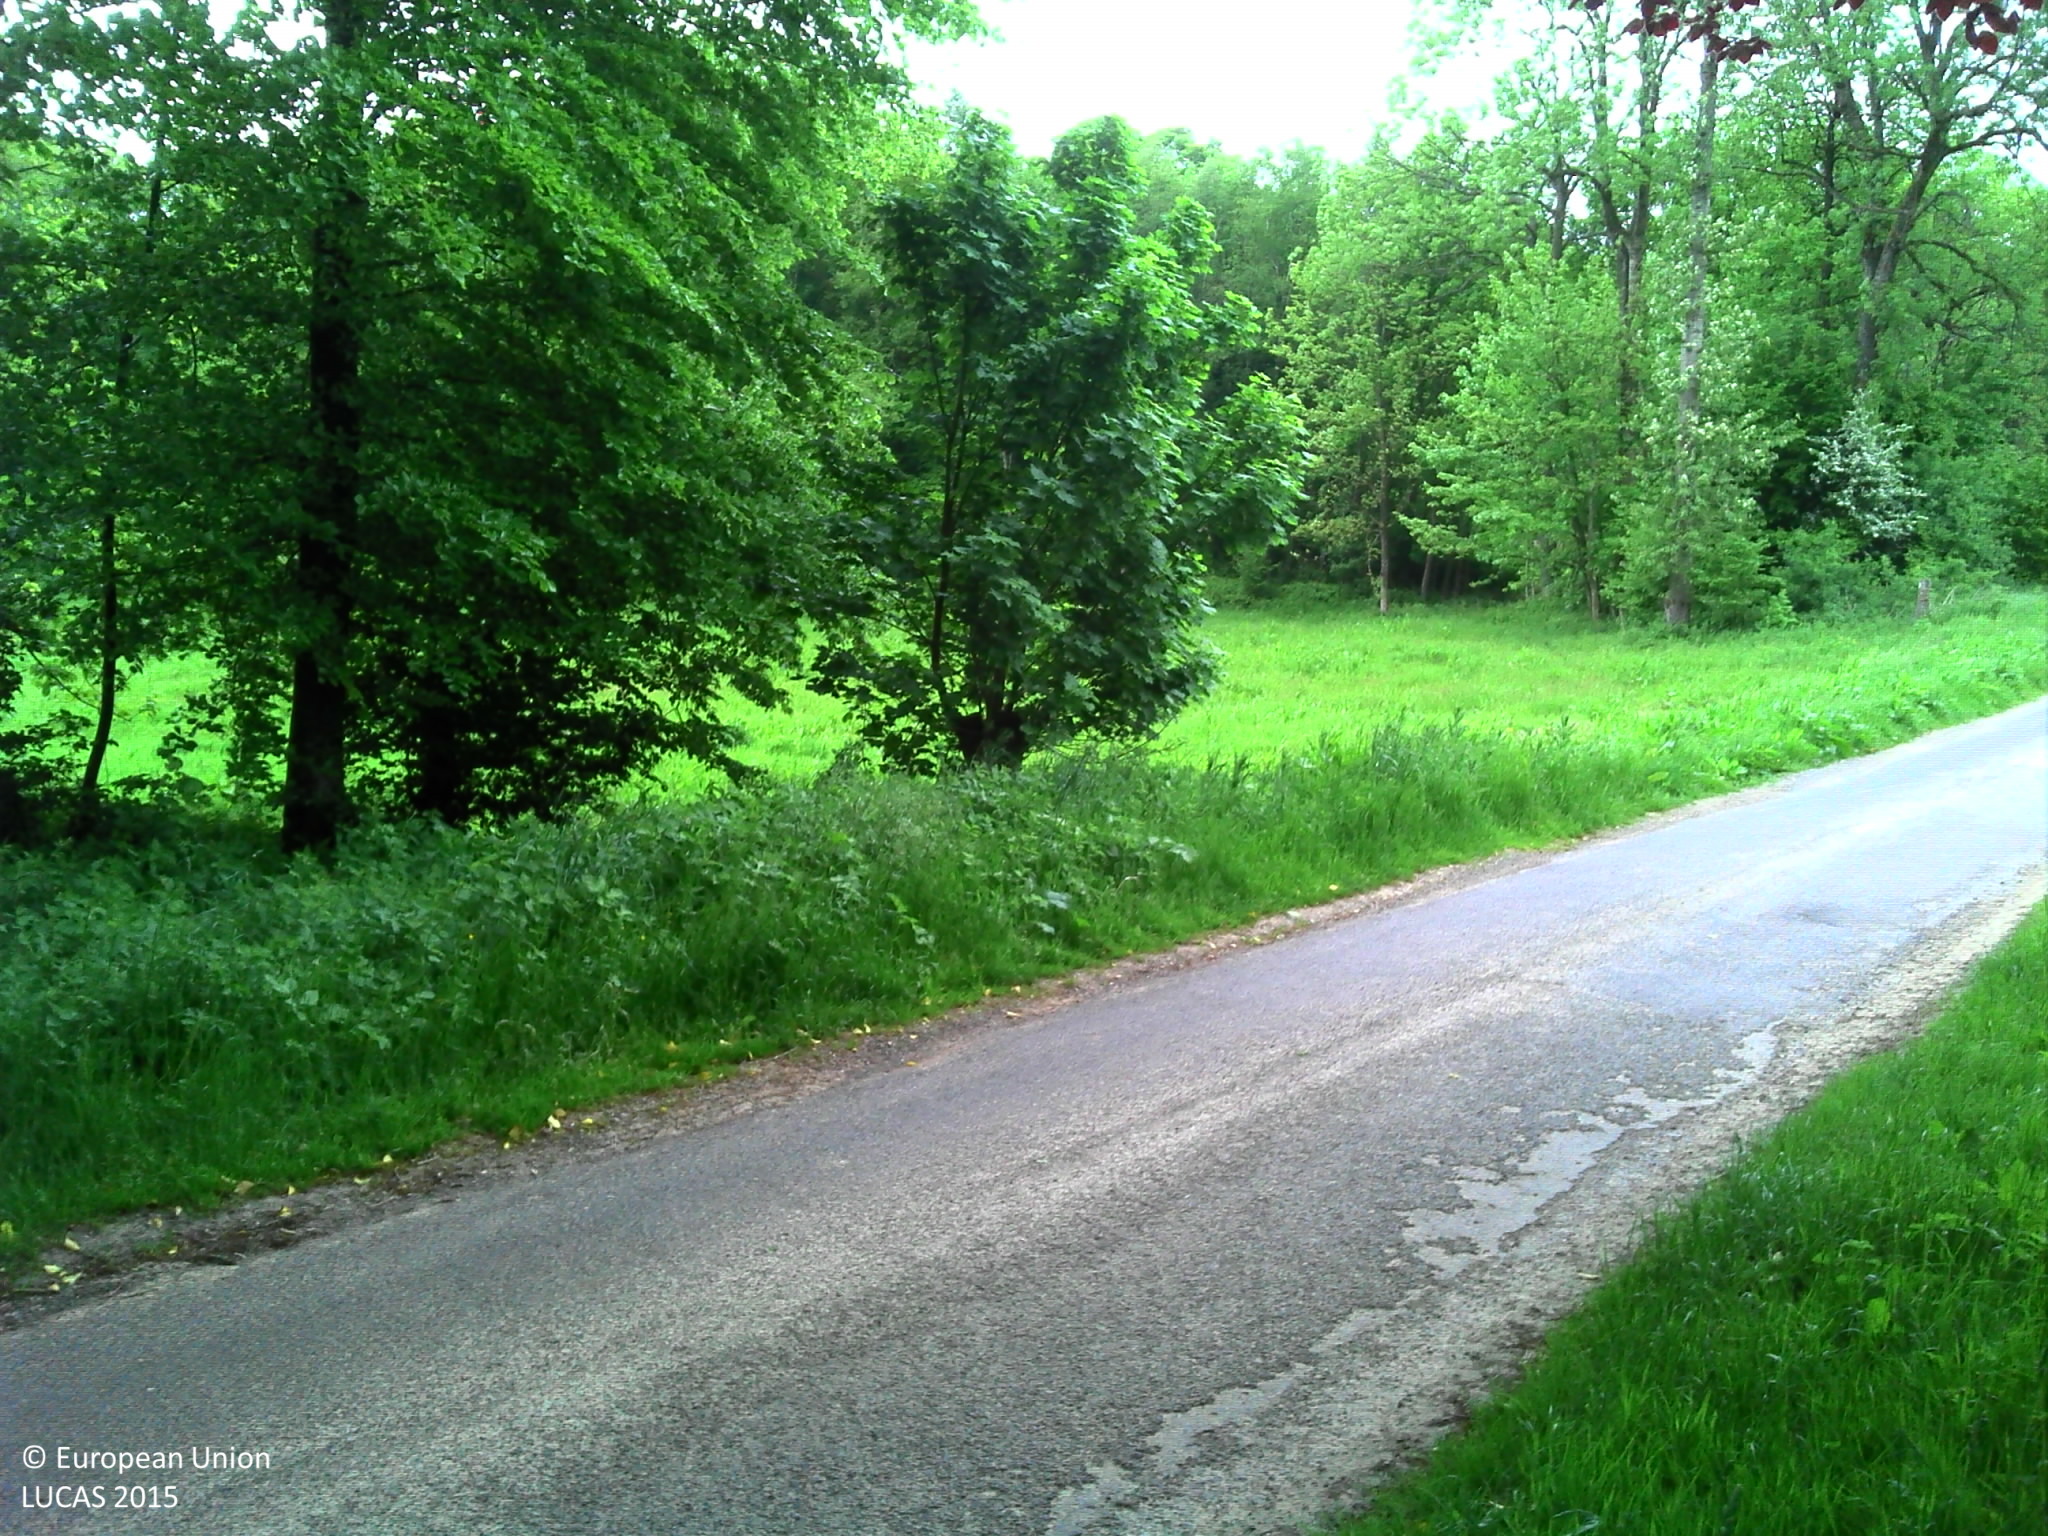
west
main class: Woodland
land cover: Broadleaved woodland
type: acidophilous oak and oak-birch forest
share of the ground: 25 - 50 %
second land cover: Grassland without tree/shrub cover
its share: > 75 %
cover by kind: herbaceous plants 80 %, broadleaved forest trees 15 %, coniferous forest trees 5 %
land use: Forestry
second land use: Agriculture (excluding fallow land and kitchen gardens)
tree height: > 5 m
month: May
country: FR
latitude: 50.4865
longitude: 2.0779
